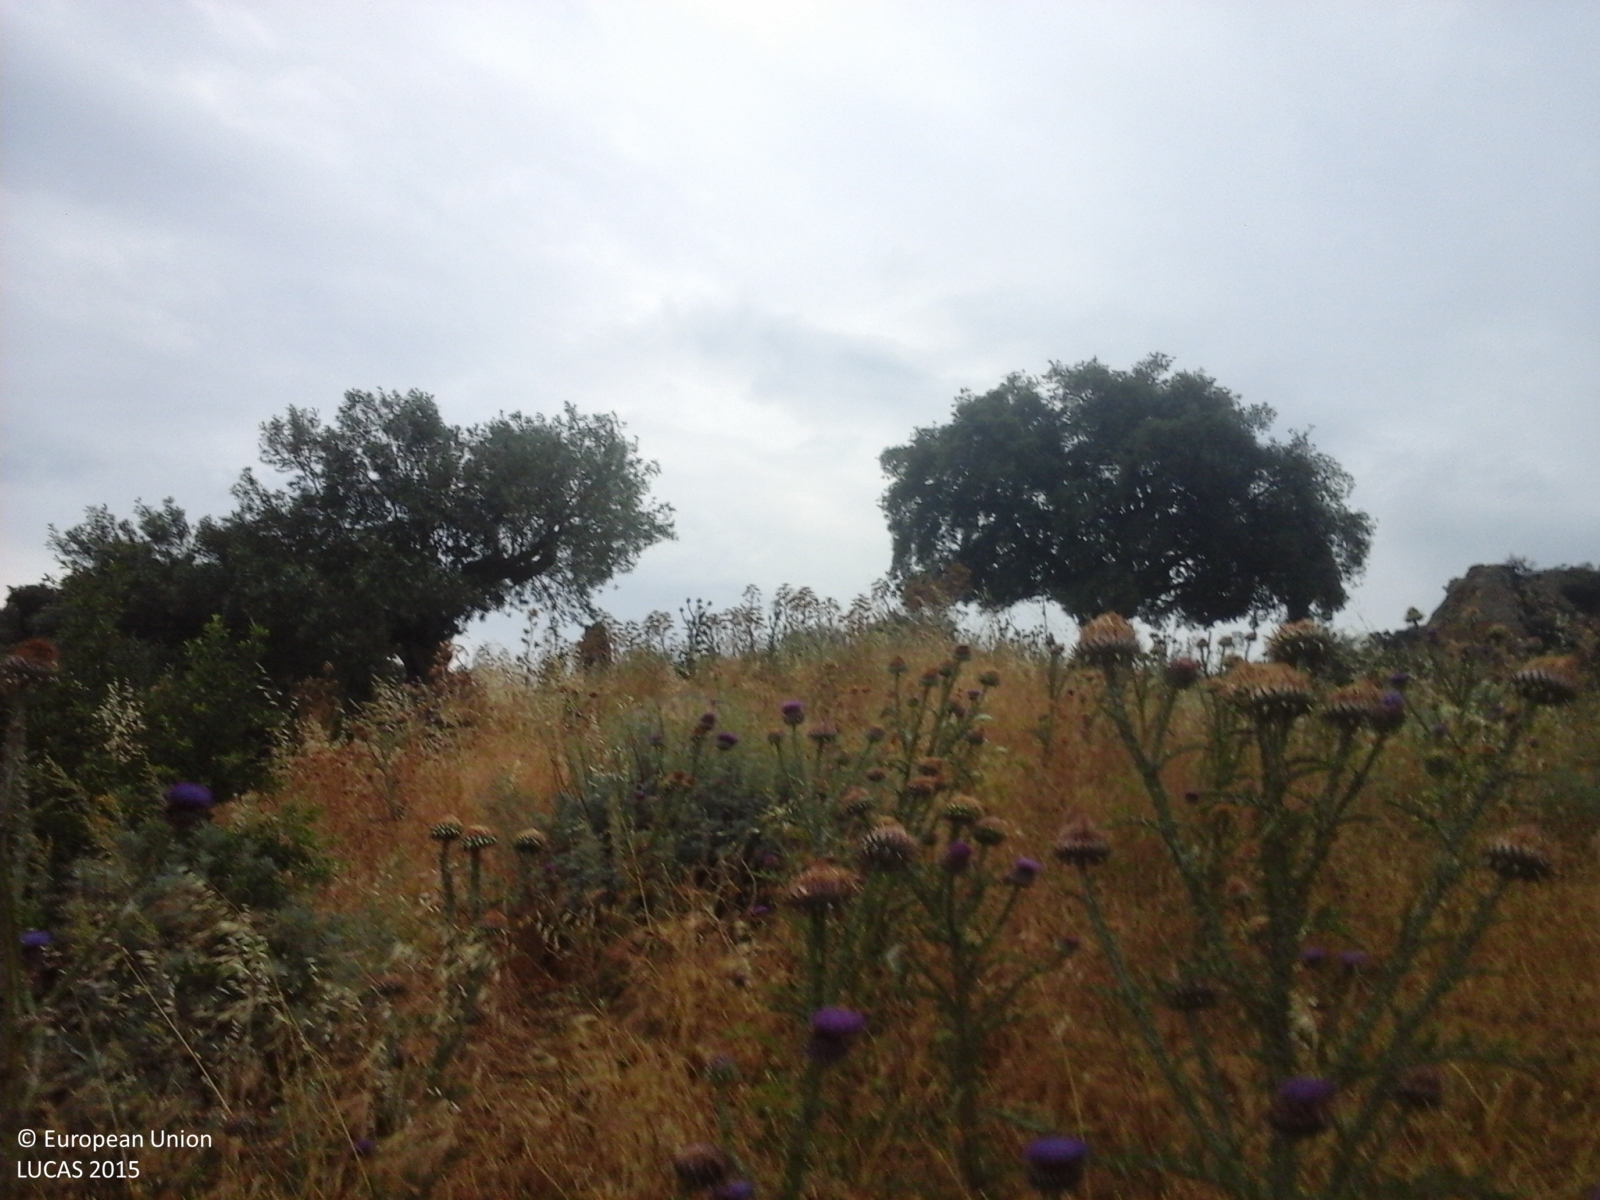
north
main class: Grassland
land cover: Grassland with sparse tree/shrub cover
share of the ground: > 75 %
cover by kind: herbaceous plants 75 %, unconsolidated bare surface 15 %, broadleaved forest trees 5 %, shrubs 5 %
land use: Agriculture (excluding fallow land and kitchen gardens)
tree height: < 5 m
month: June
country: IT
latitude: 37.7150
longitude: 14.4718
